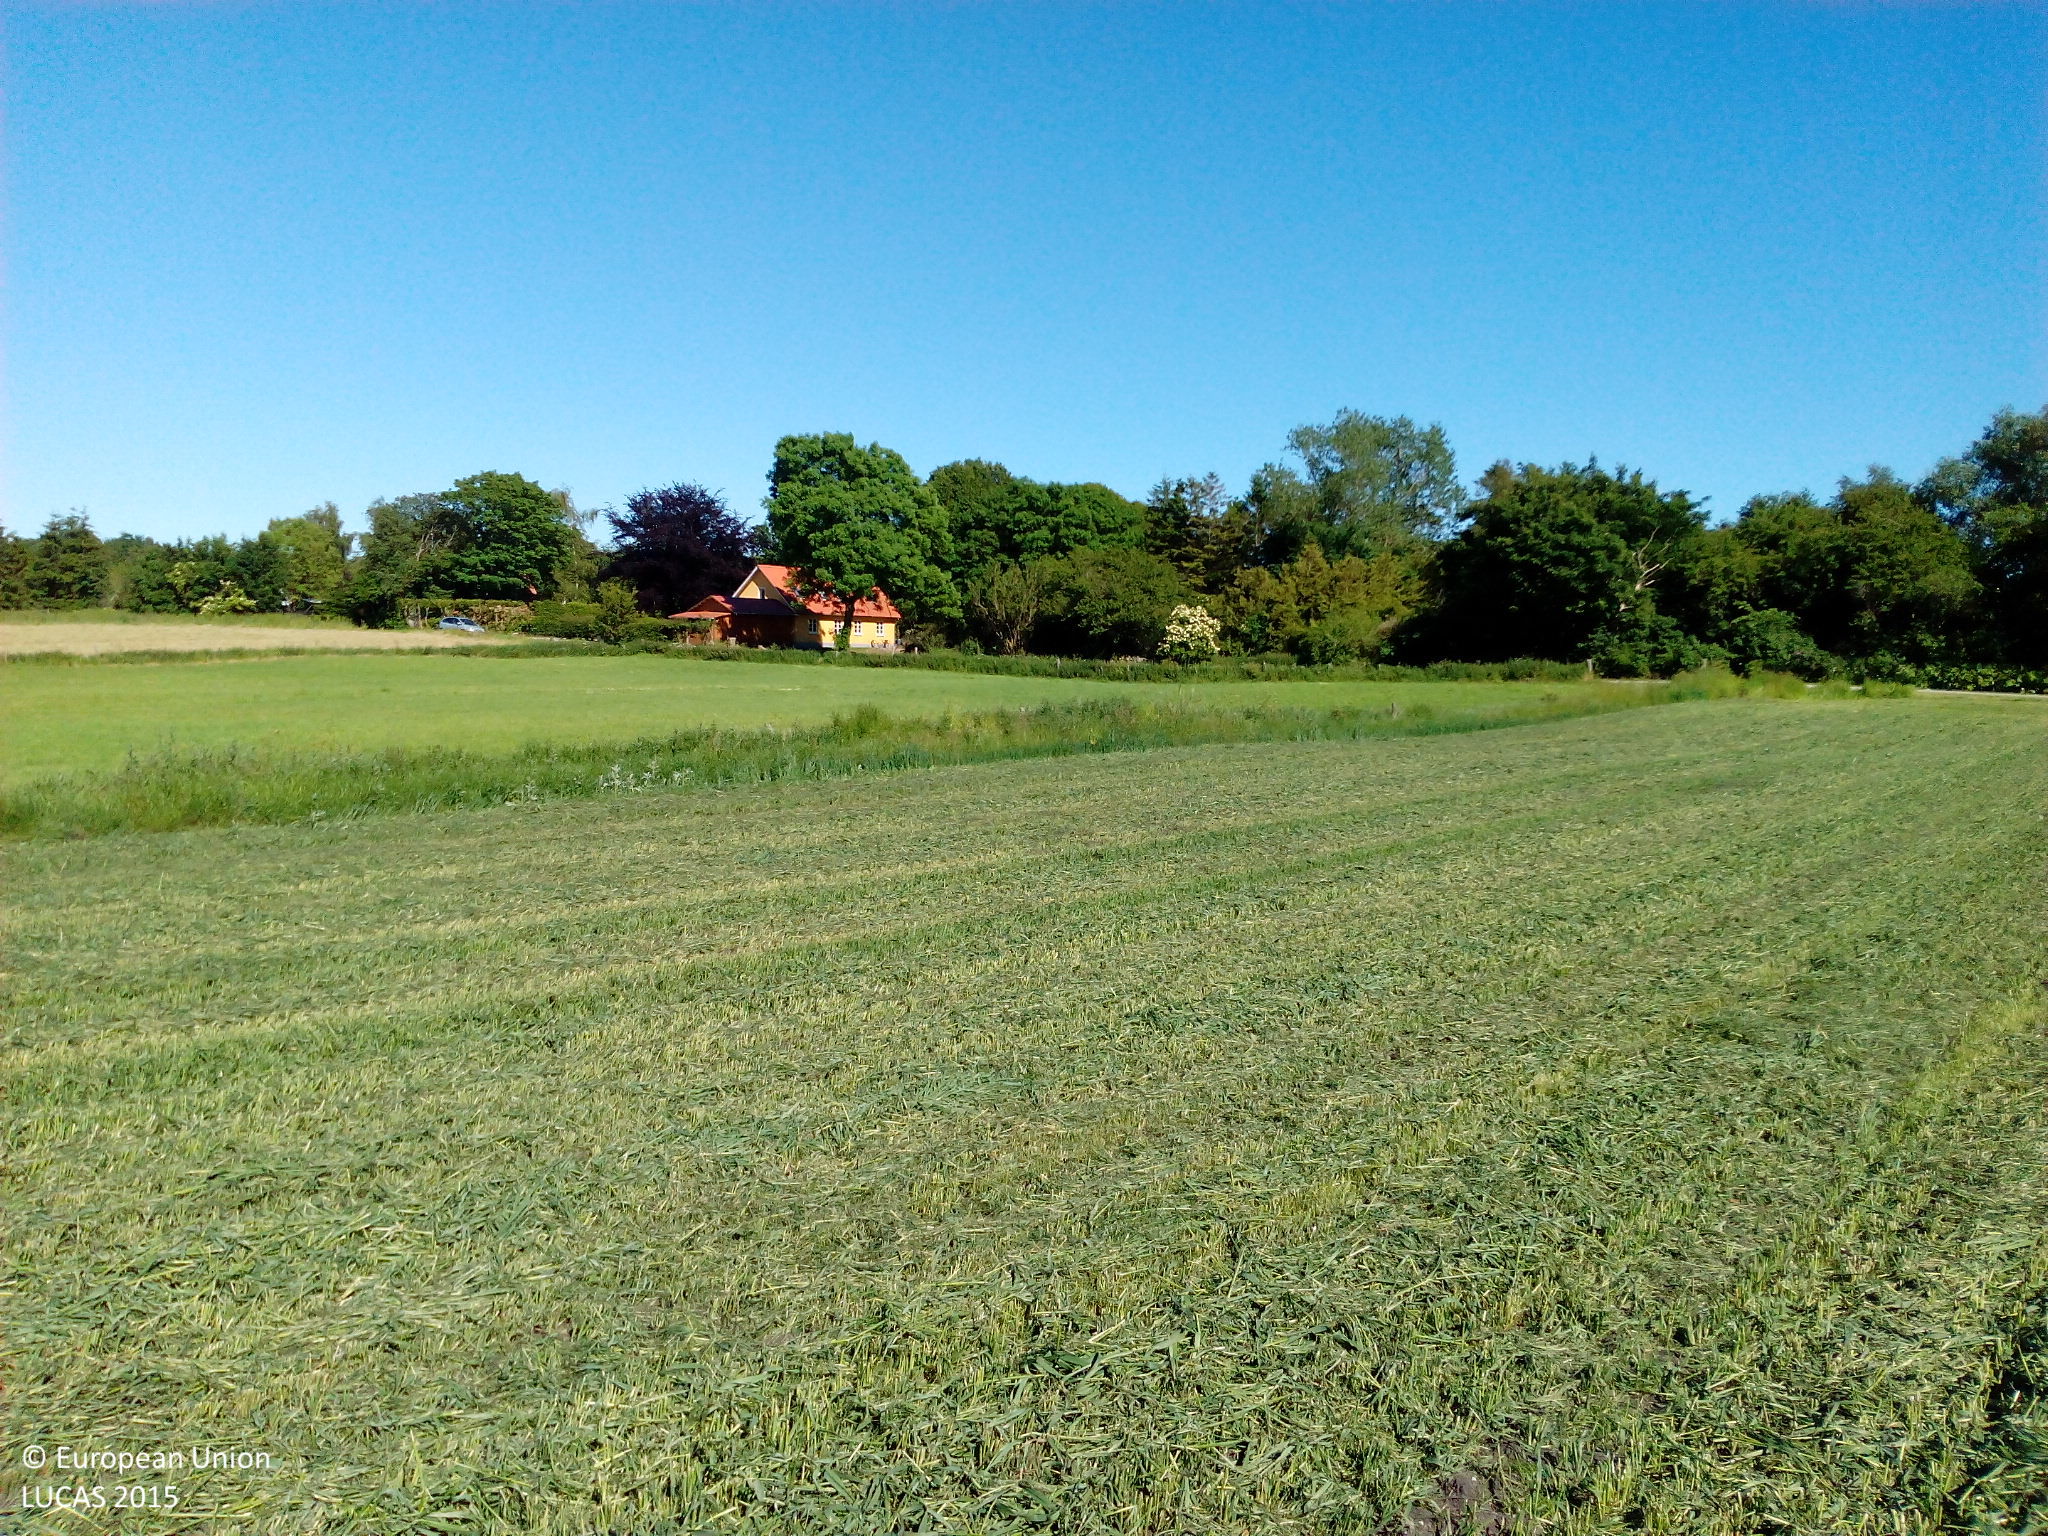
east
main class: Cropland
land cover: Mixed cereals for fodder
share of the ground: 50 - 75 %
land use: Agriculture (excluding fallow land and kitchen gardens)
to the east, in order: Mixed cereals for fodder; Grass margins; Grassland without tree/shrub cover; Fences; Grass margins; Paved roads, cycling and walking lanes; Grass margins; Broadleaved woodland; Grassland without tree/shrub cover; Broadleaved woodland; Grassland without tree/shrub cover
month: July
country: DK
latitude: 56.4727
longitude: 10.8269
